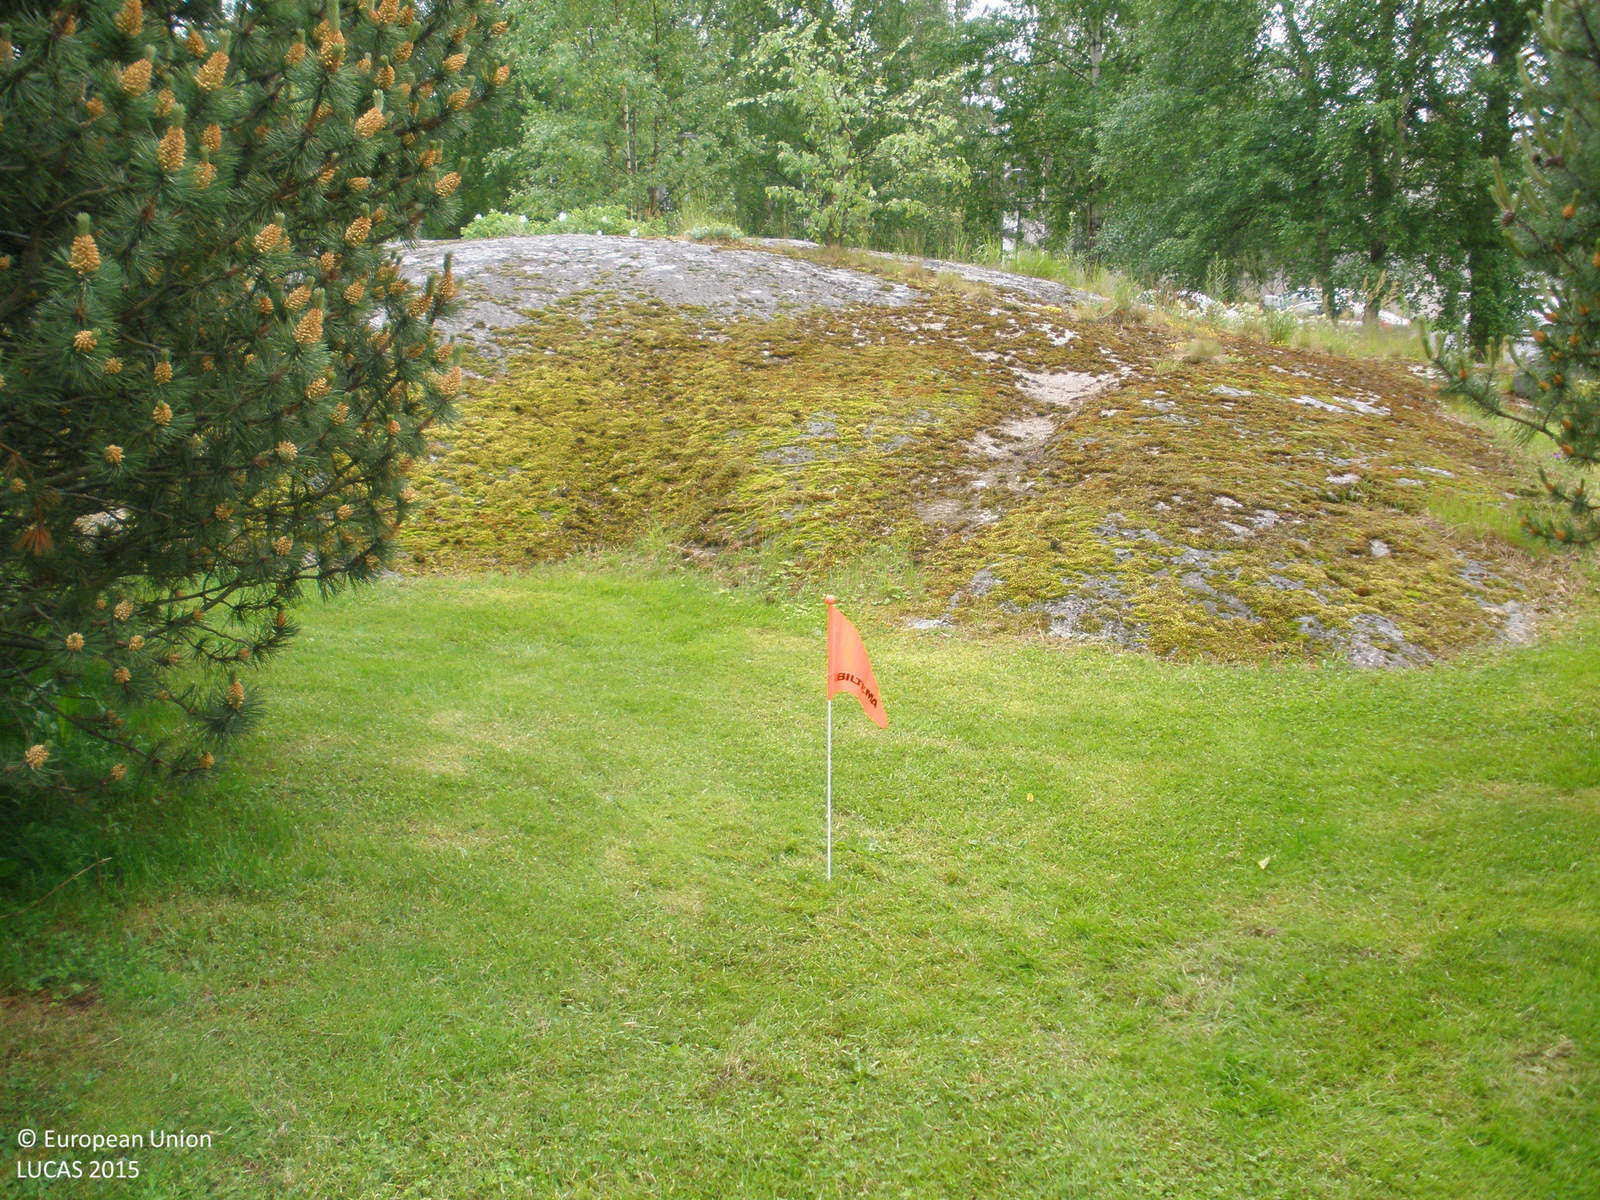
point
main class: Grassland
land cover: Grassland with sparse tree/shrub cover
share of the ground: > 75 %
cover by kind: herbaceous plants 95 %, coniferous forest trees 5 %
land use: Community services
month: June
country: FI
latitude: 61.0785
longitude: 23.5597
